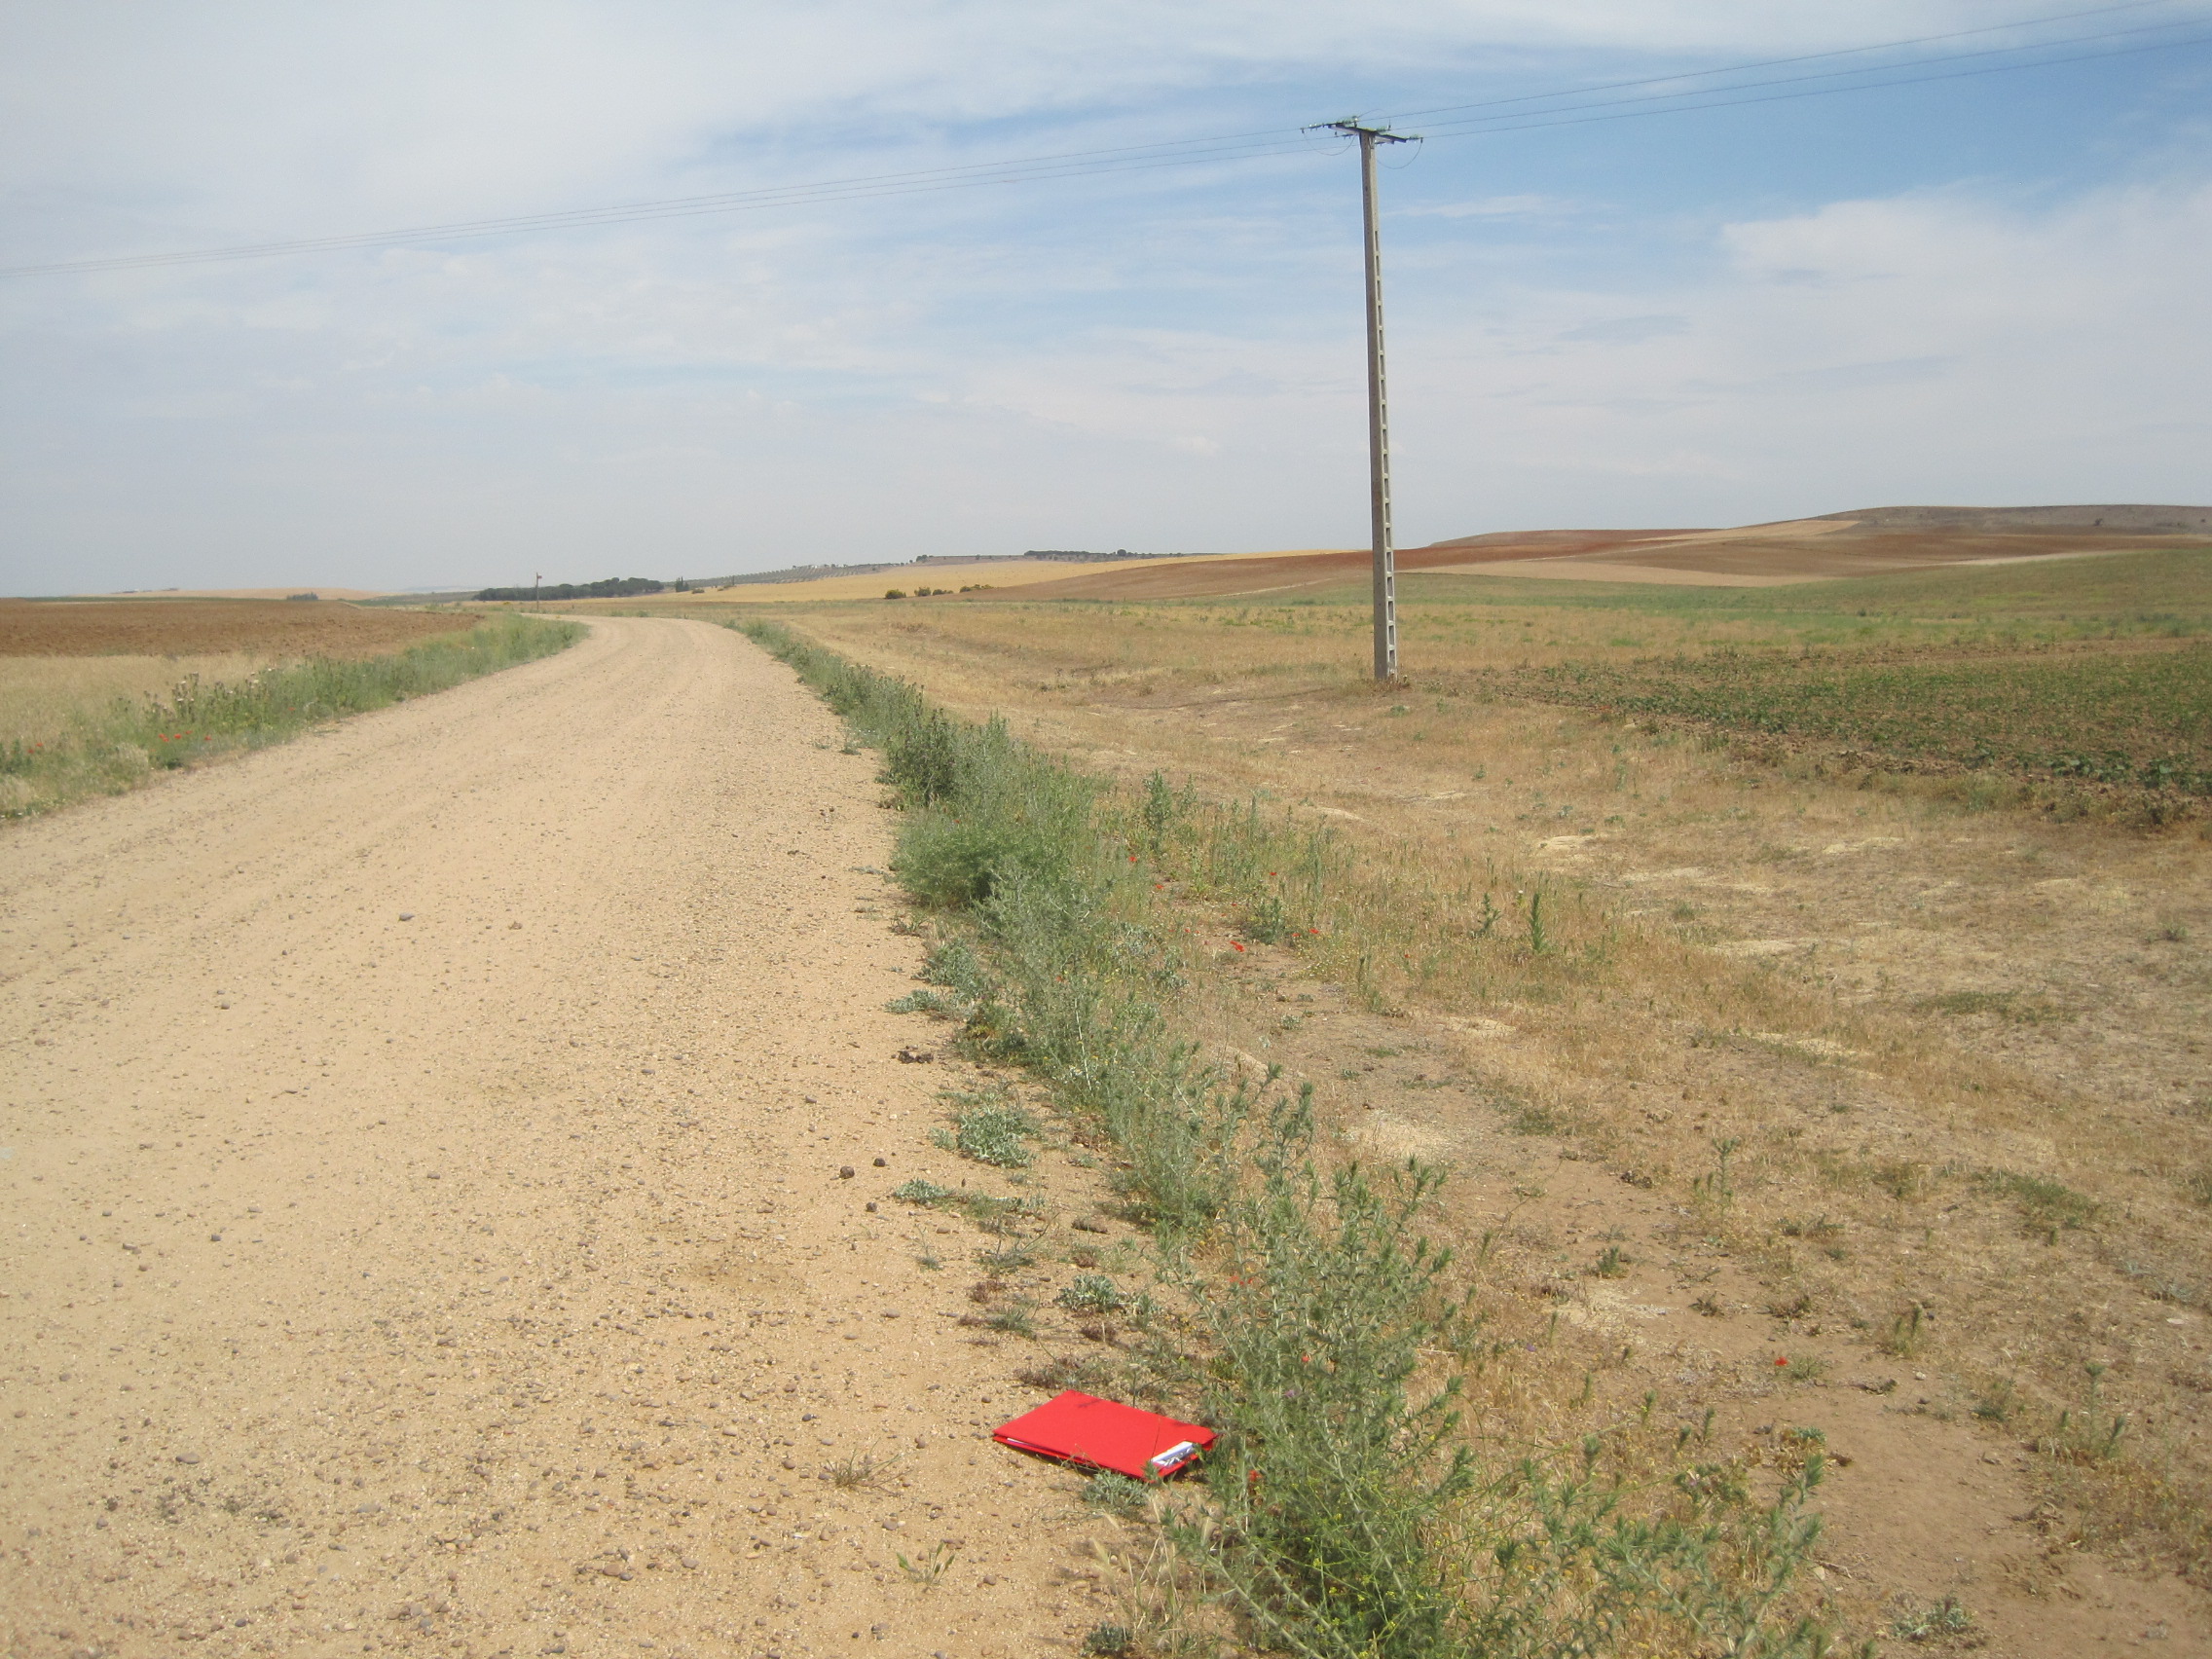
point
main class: Grassland
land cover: Grassland without tree/shrub cover
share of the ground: > 75 %
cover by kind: herbaceous plants 80 %, unconsolidated bare surface 20 %
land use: Agriculture (excluding fallow land and kitchen gardens)
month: June
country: ES
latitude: 41.3713
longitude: -5.0763
